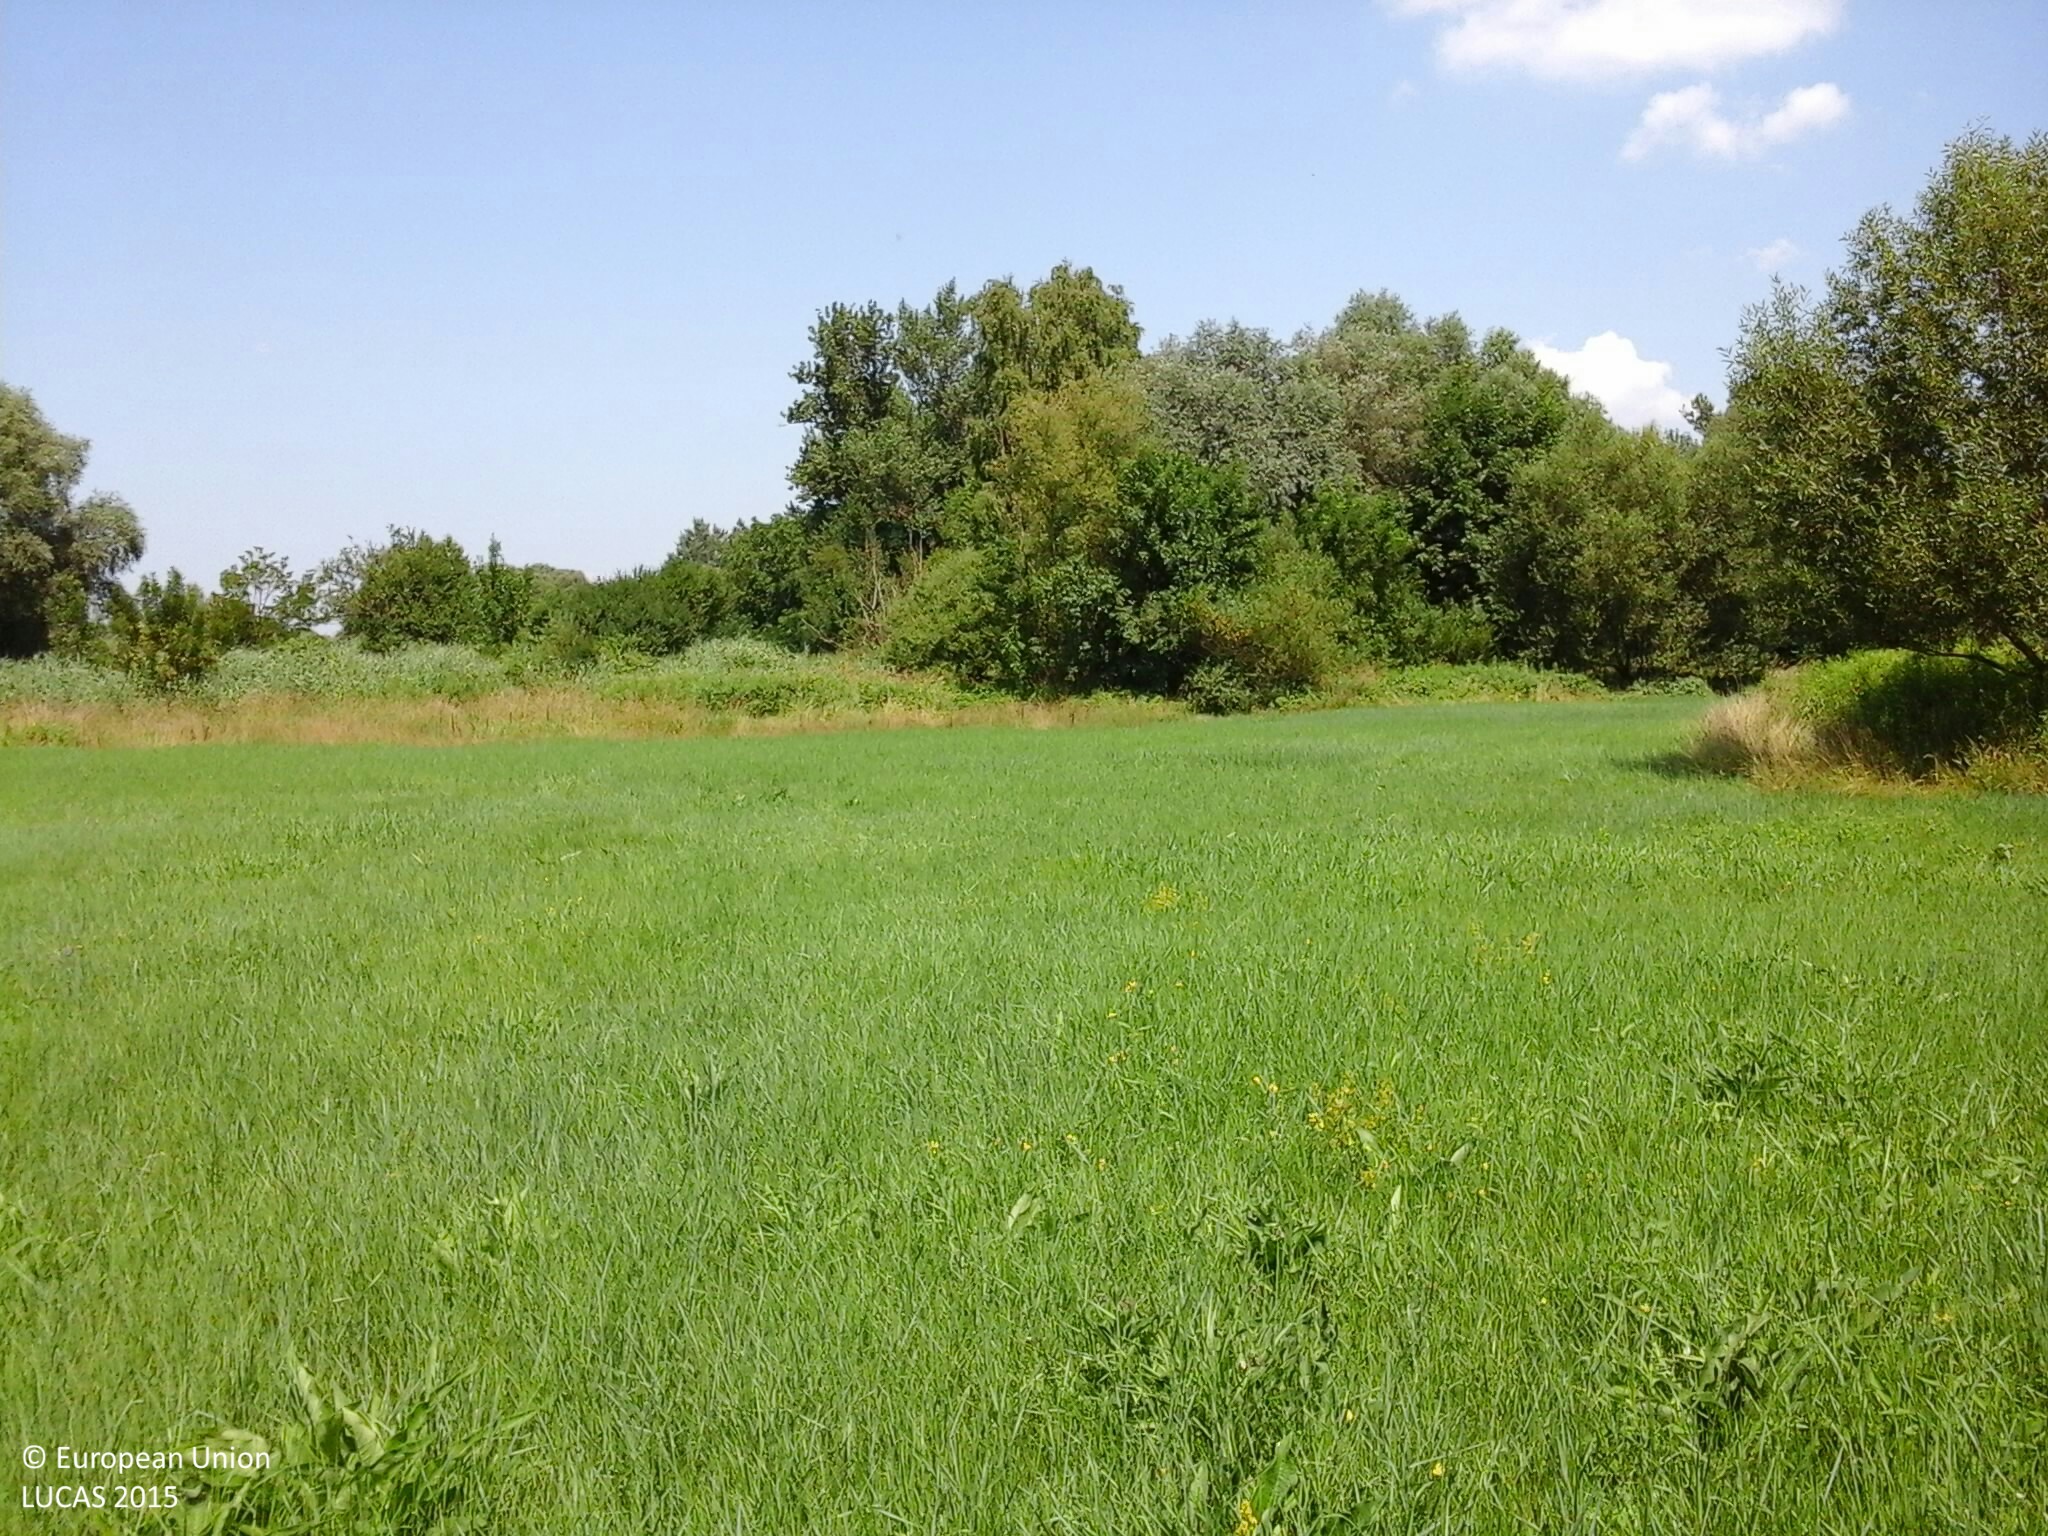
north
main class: Grassland
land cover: Grassland without tree/shrub cover
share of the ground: > 75 %
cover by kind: herbaceous plants 100 %
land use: Agriculture (excluding fallow land and kitchen gardens)
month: July
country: HU
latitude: 46.9969
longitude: 16.5911
